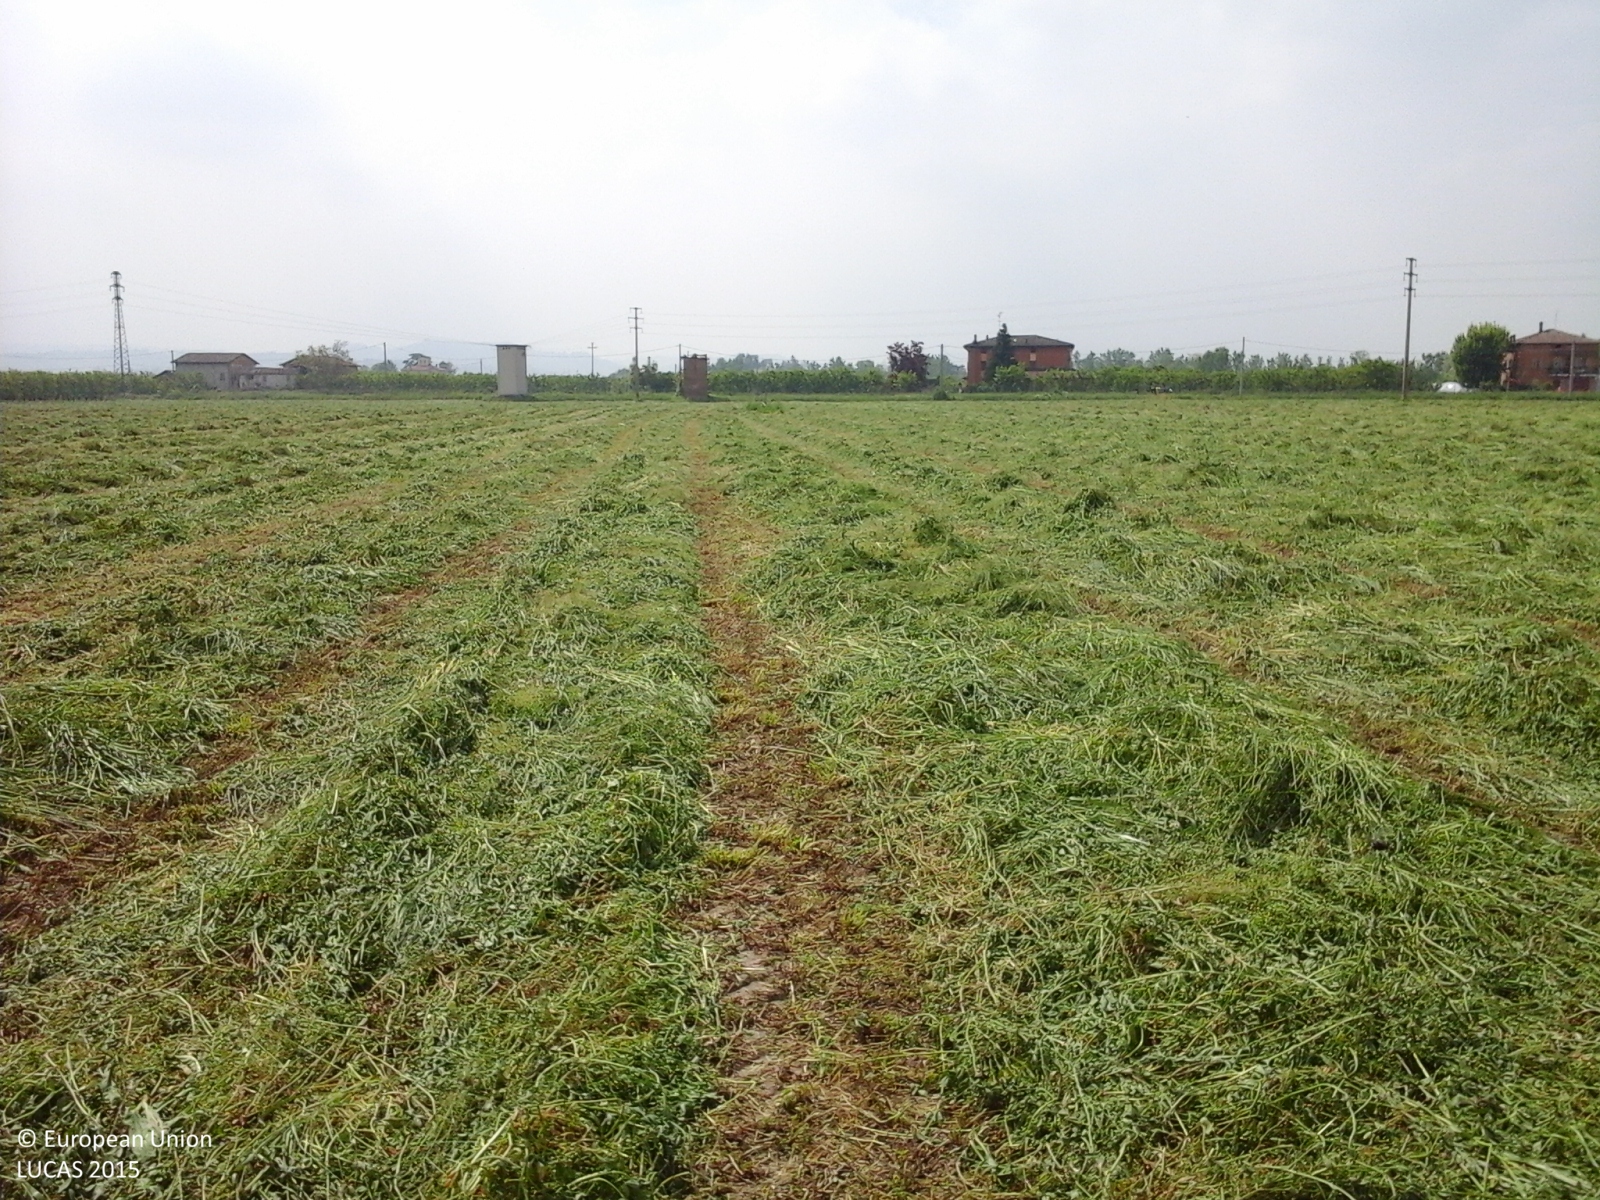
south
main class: Cropland
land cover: Lucerne
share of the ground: 10 - 25 %
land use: Agriculture (excluding fallow land and kitchen gardens)
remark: Harvested field
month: May
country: IT
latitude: 44.5257
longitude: 11.0421
